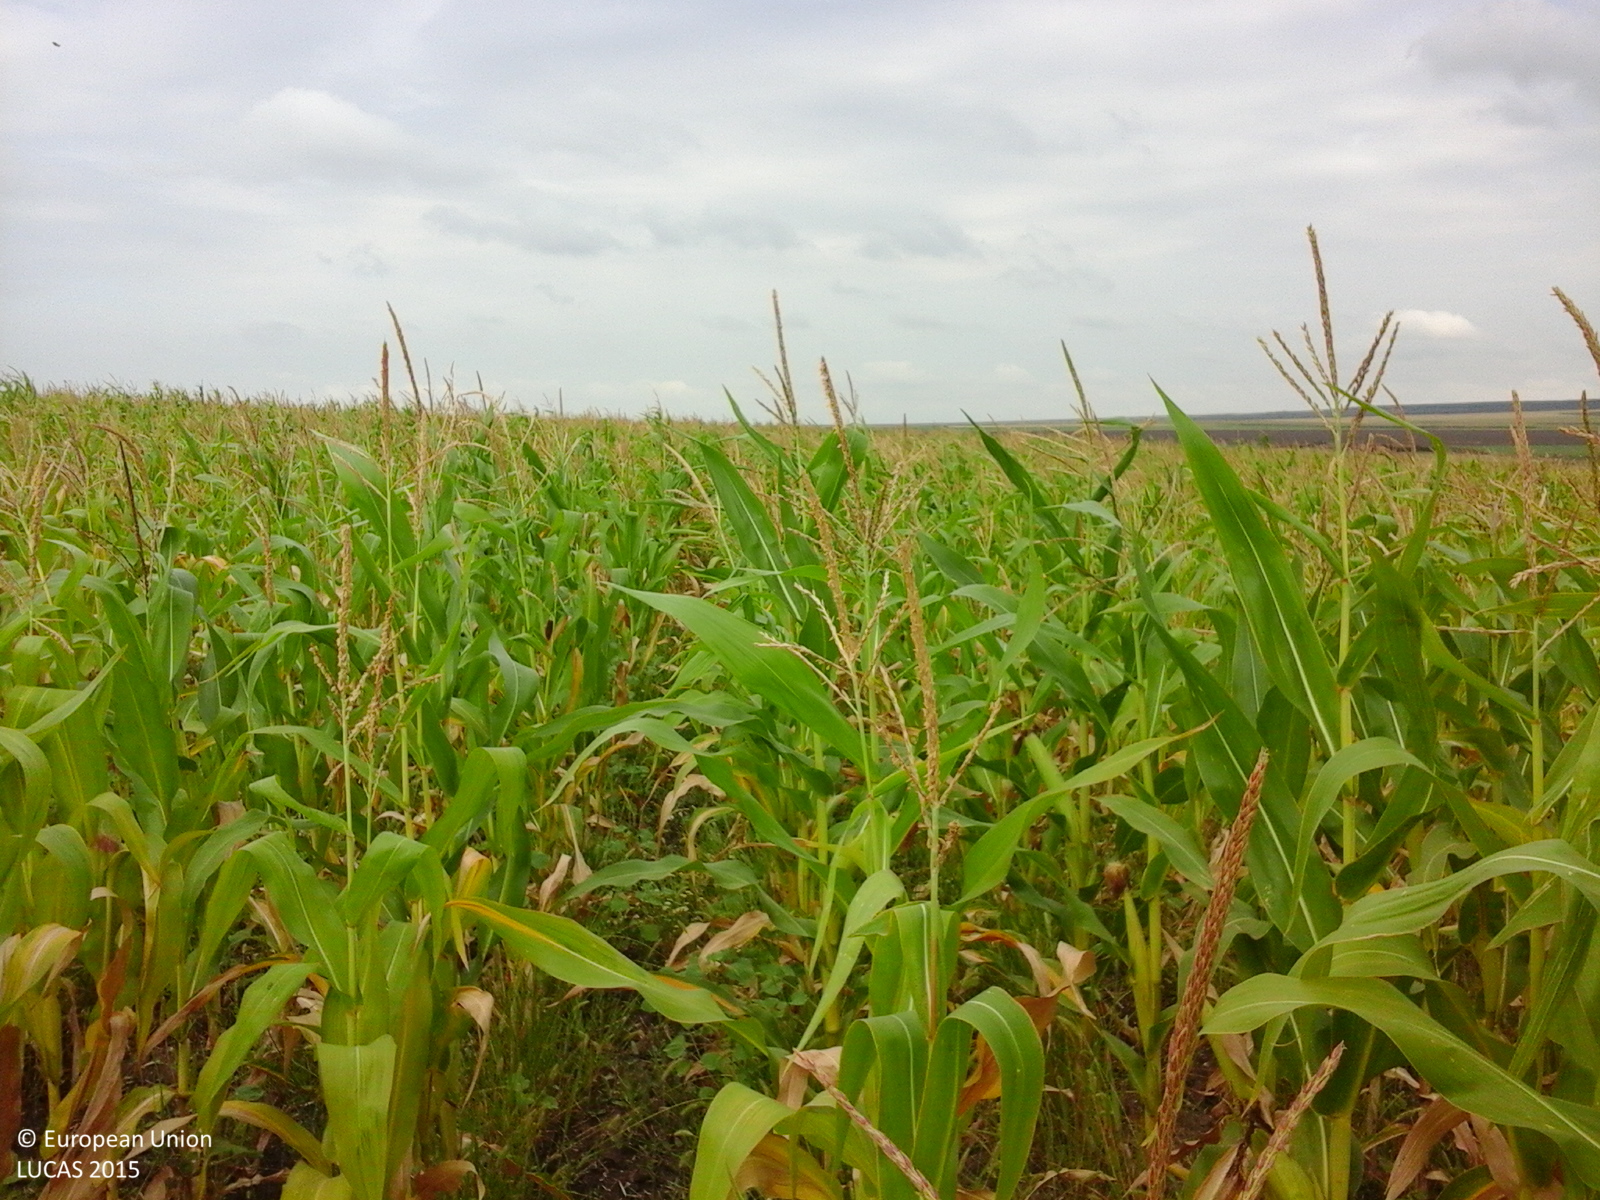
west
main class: Cropland
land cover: Maize
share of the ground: > 75 %
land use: Agriculture (excluding fallow land and kitchen gardens)
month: August
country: RO
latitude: 44.7374
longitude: 28.5003
